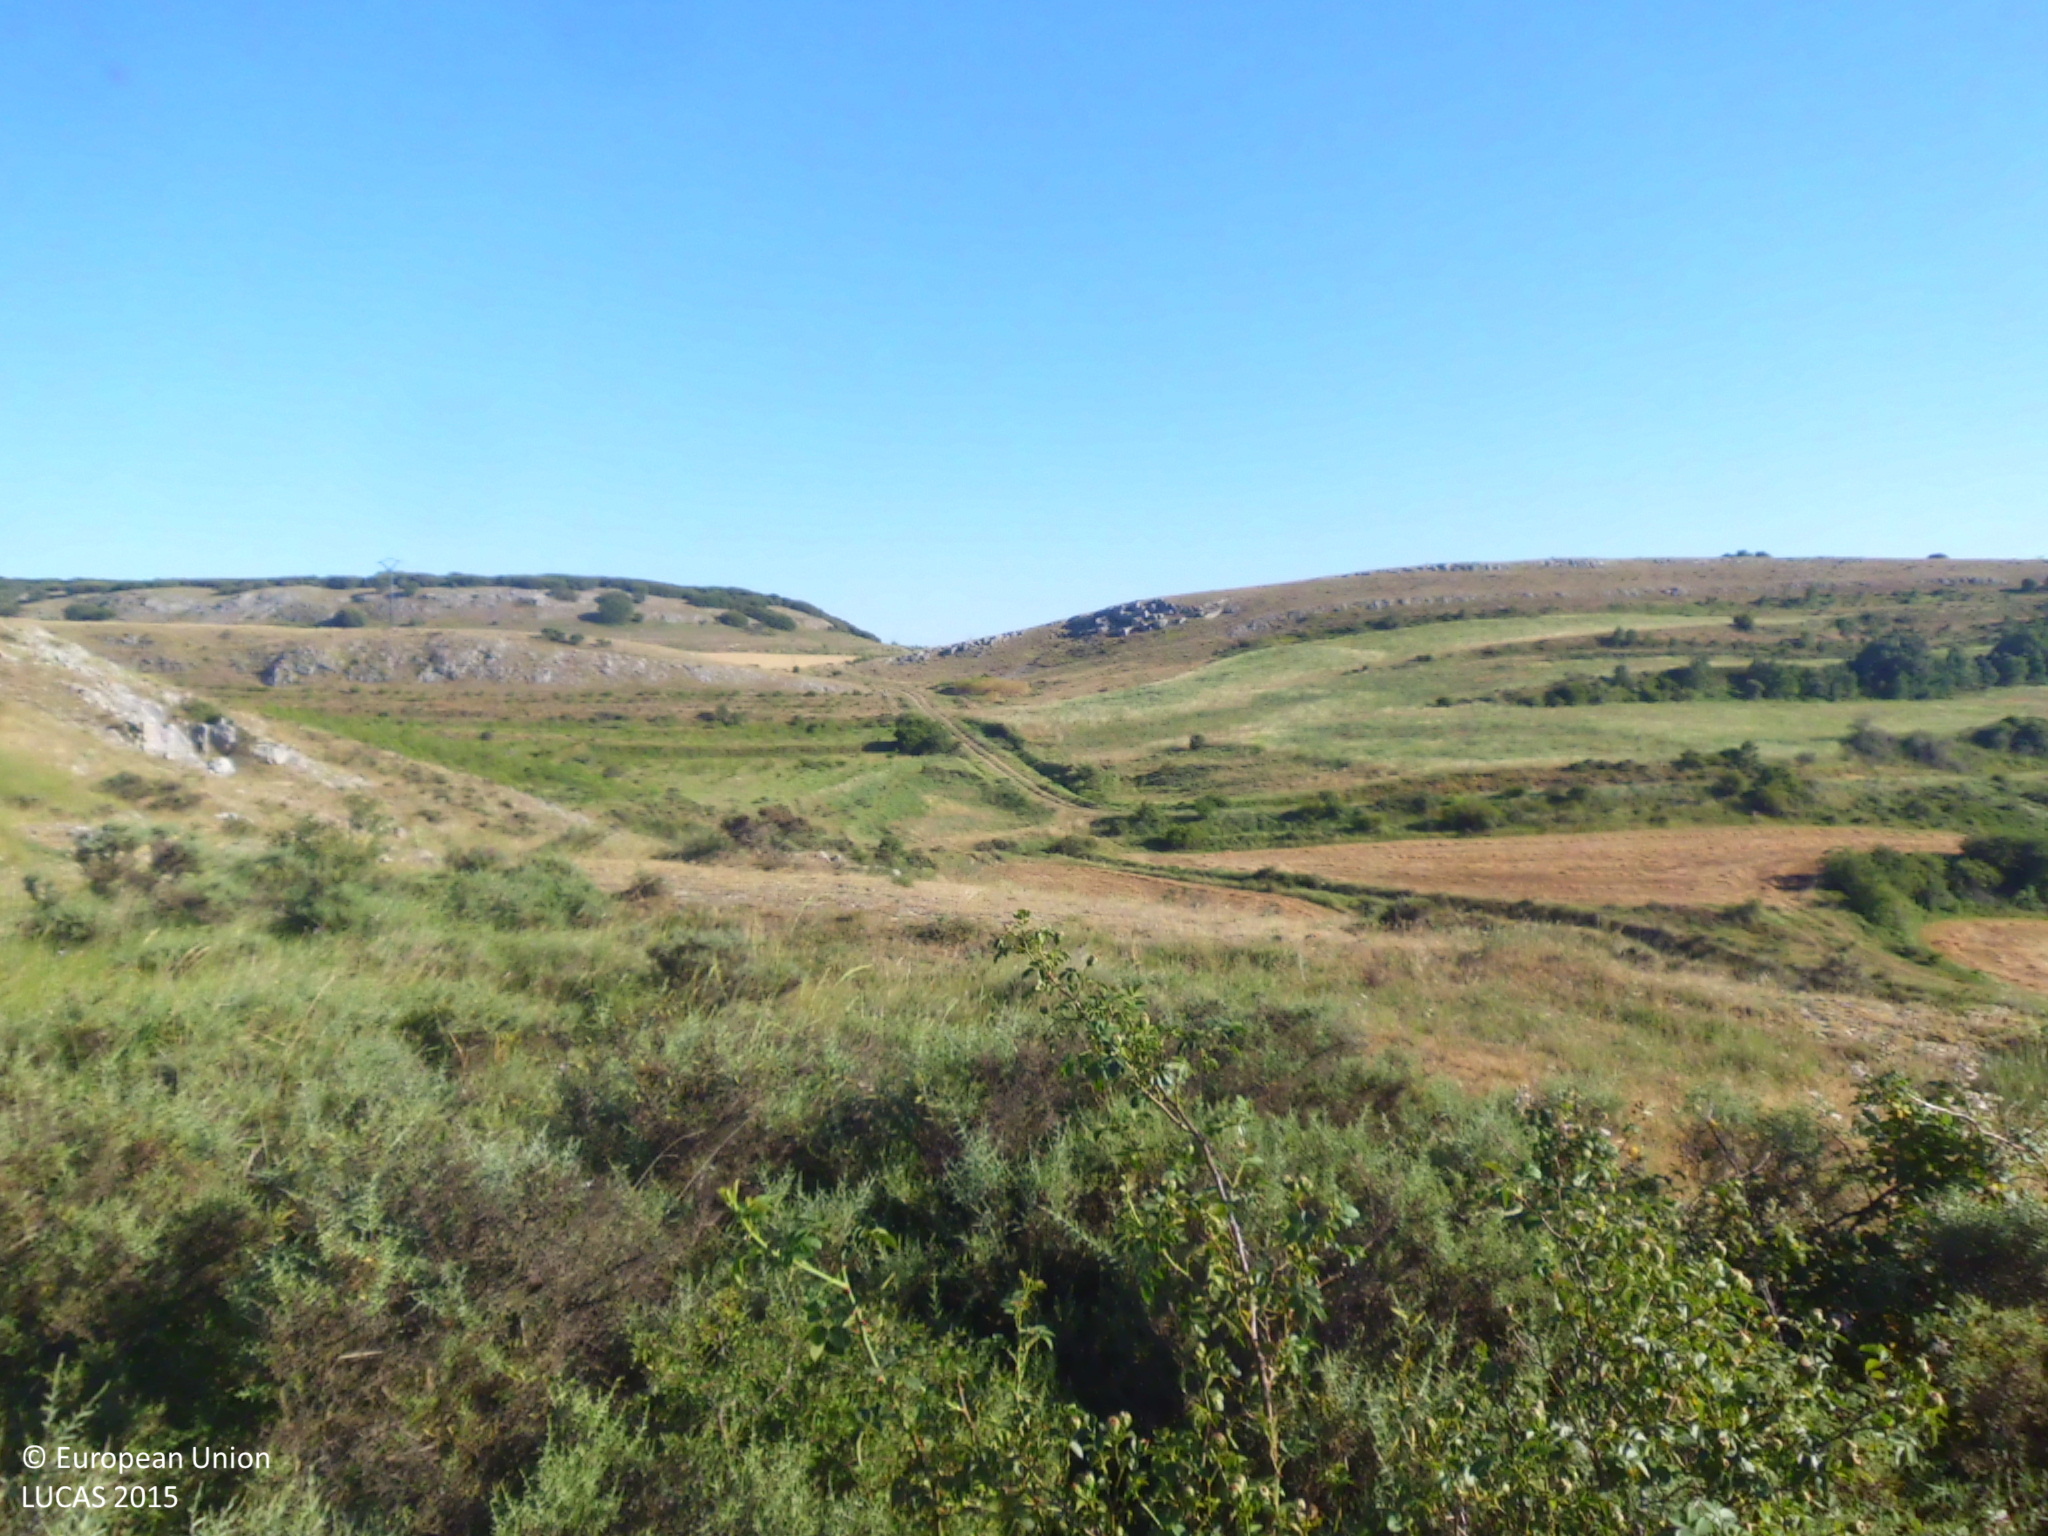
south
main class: Shrubland
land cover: Shrubland without tree cover
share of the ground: 50 - 75 %
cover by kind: shrubs 65 %, consolidated bare surface 20 %, herbaceous plants 15 %
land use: Abandoned areas
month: July
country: ES
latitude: 42.6641
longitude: -4.2623
